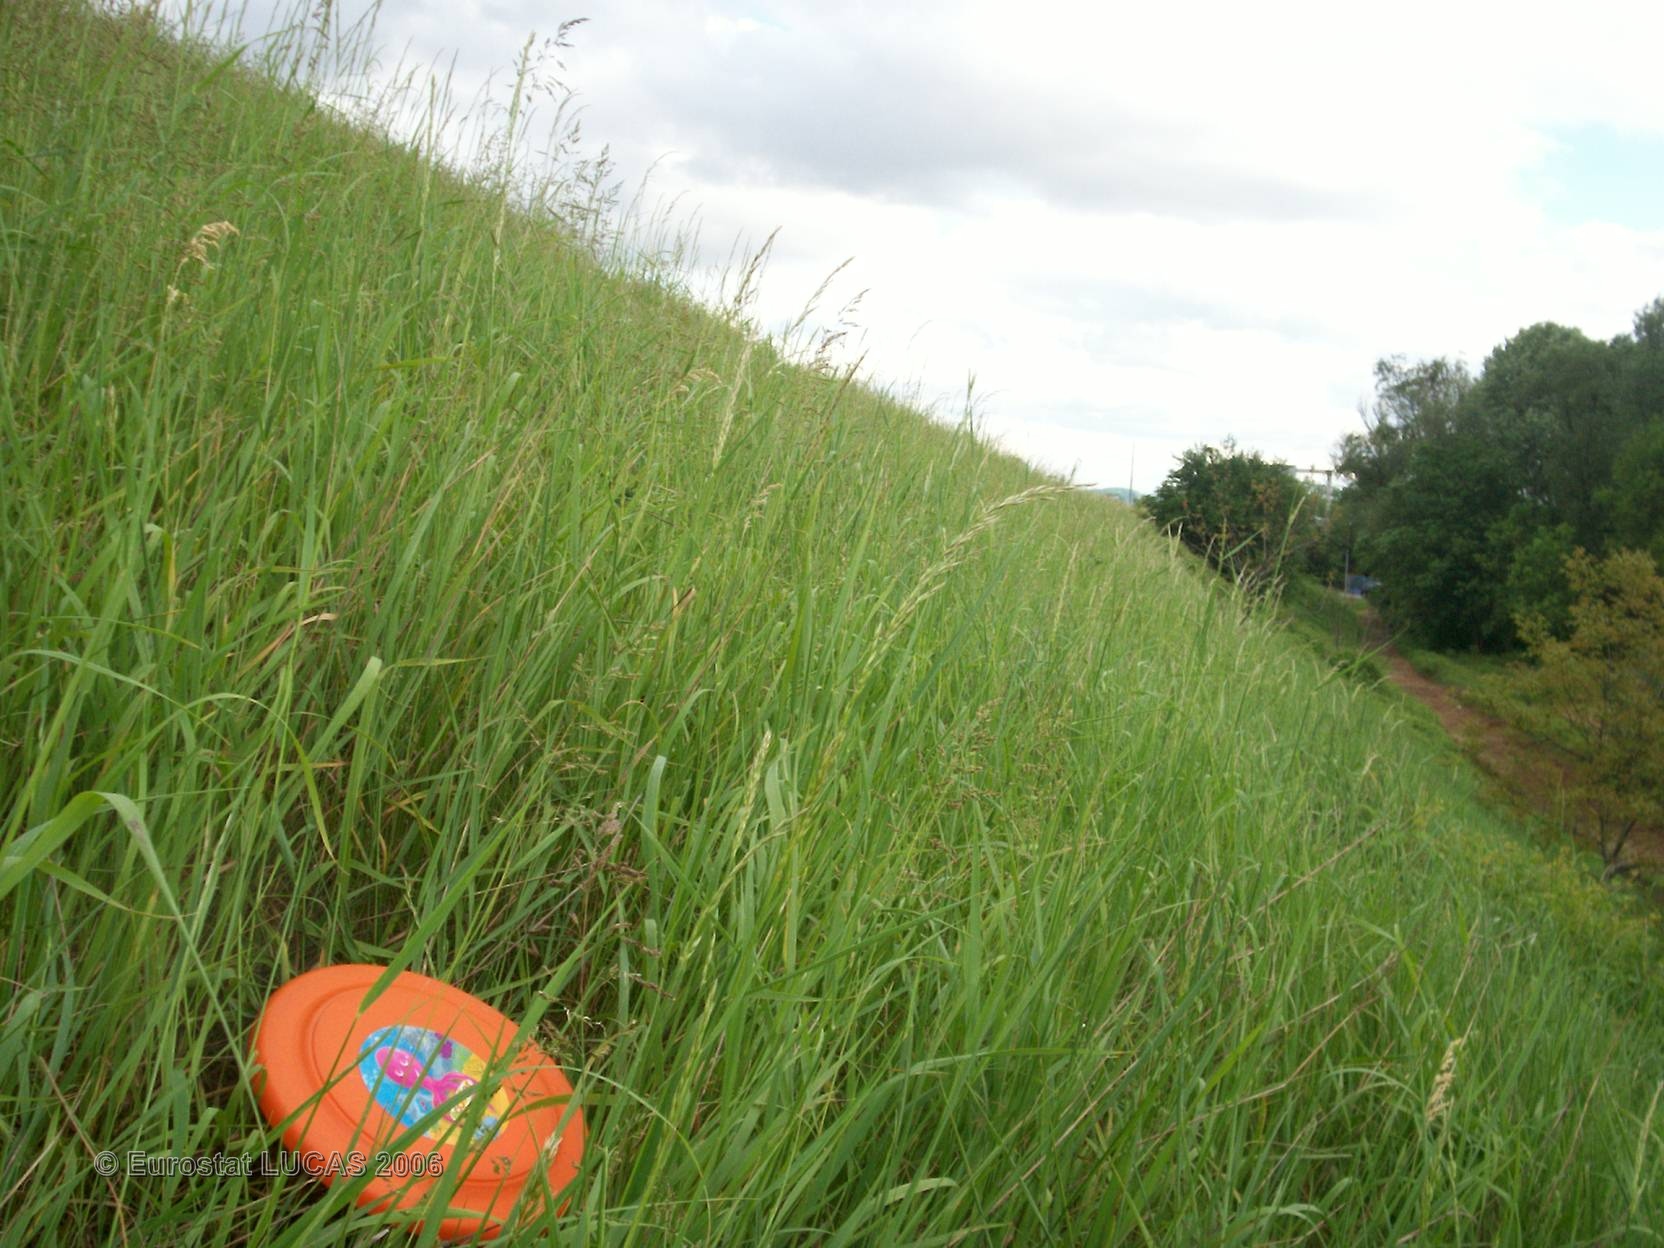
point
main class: Grassland
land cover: Grassland without tree/shrub cover
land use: Unused
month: May
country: FR
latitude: 45.9324
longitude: 4.7282
